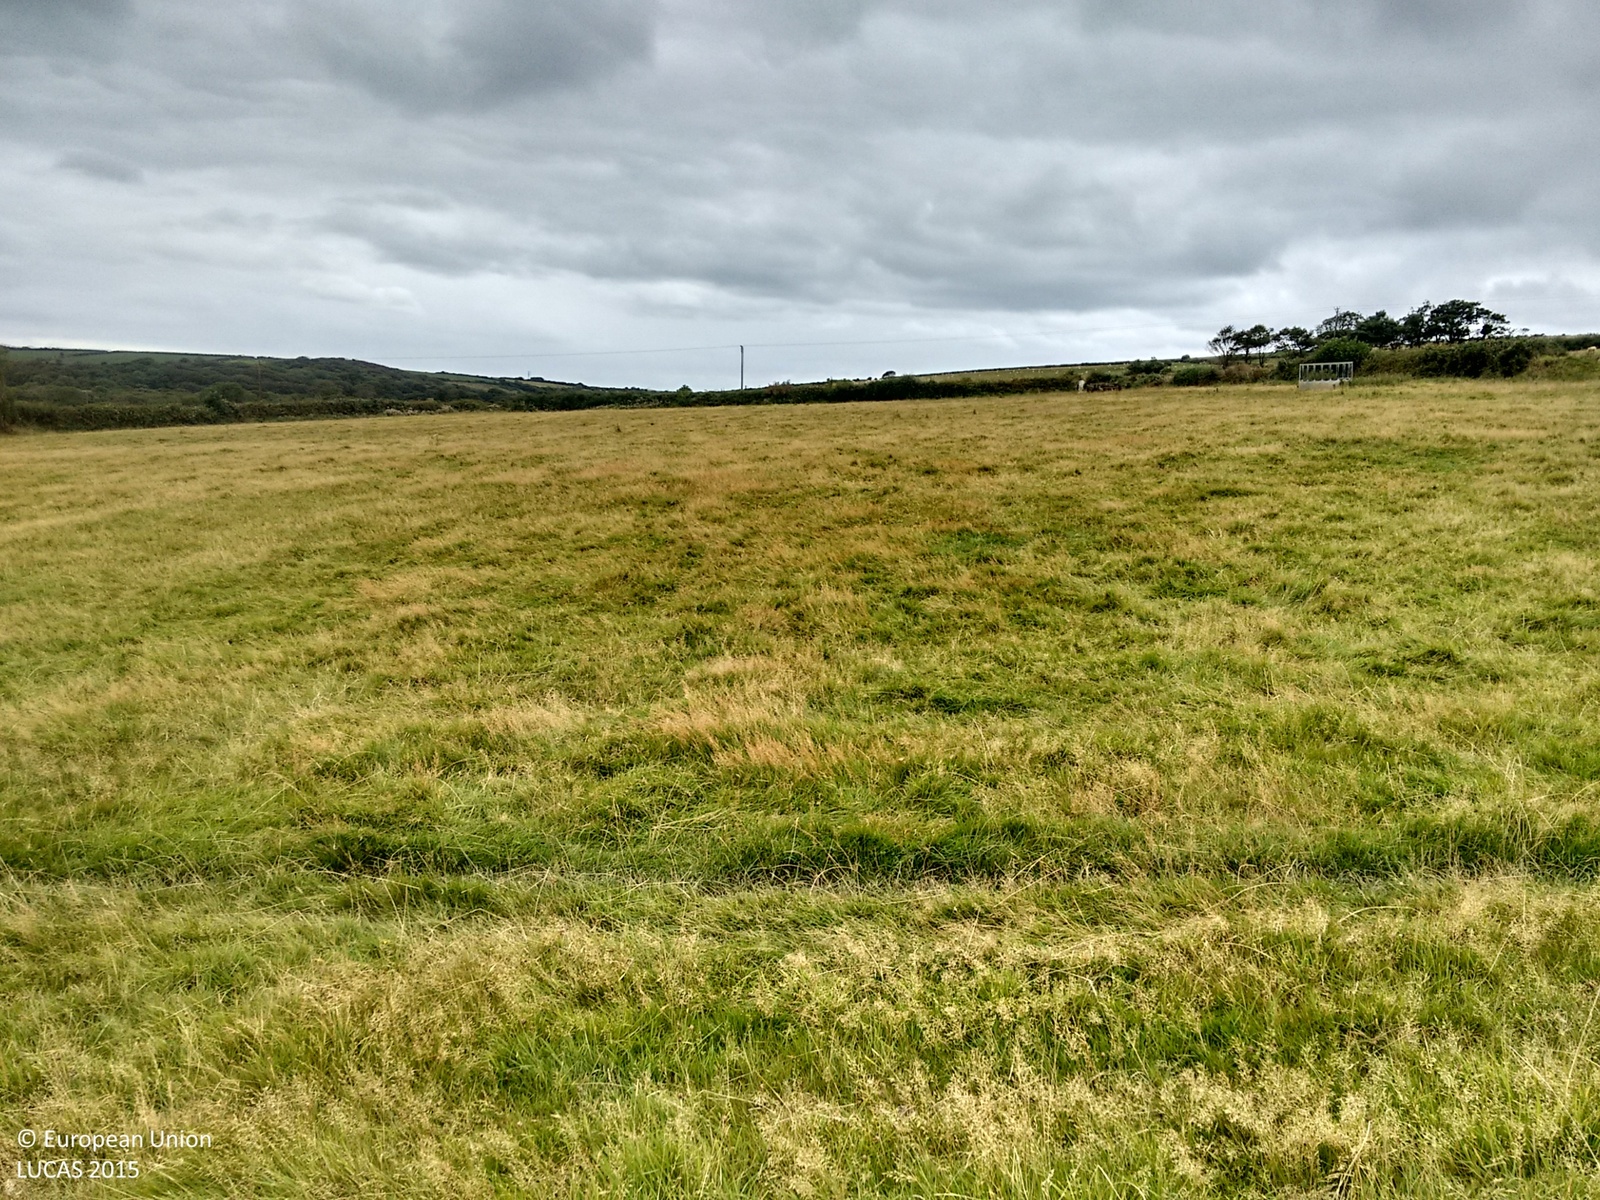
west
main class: Grassland
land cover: Grassland without tree/shrub cover
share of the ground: > 75 %
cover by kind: herbaceous plants 100 %
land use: Agriculture (excluding fallow land and kitchen gardens)
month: September
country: GB
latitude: 50.4541
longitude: -4.9457
